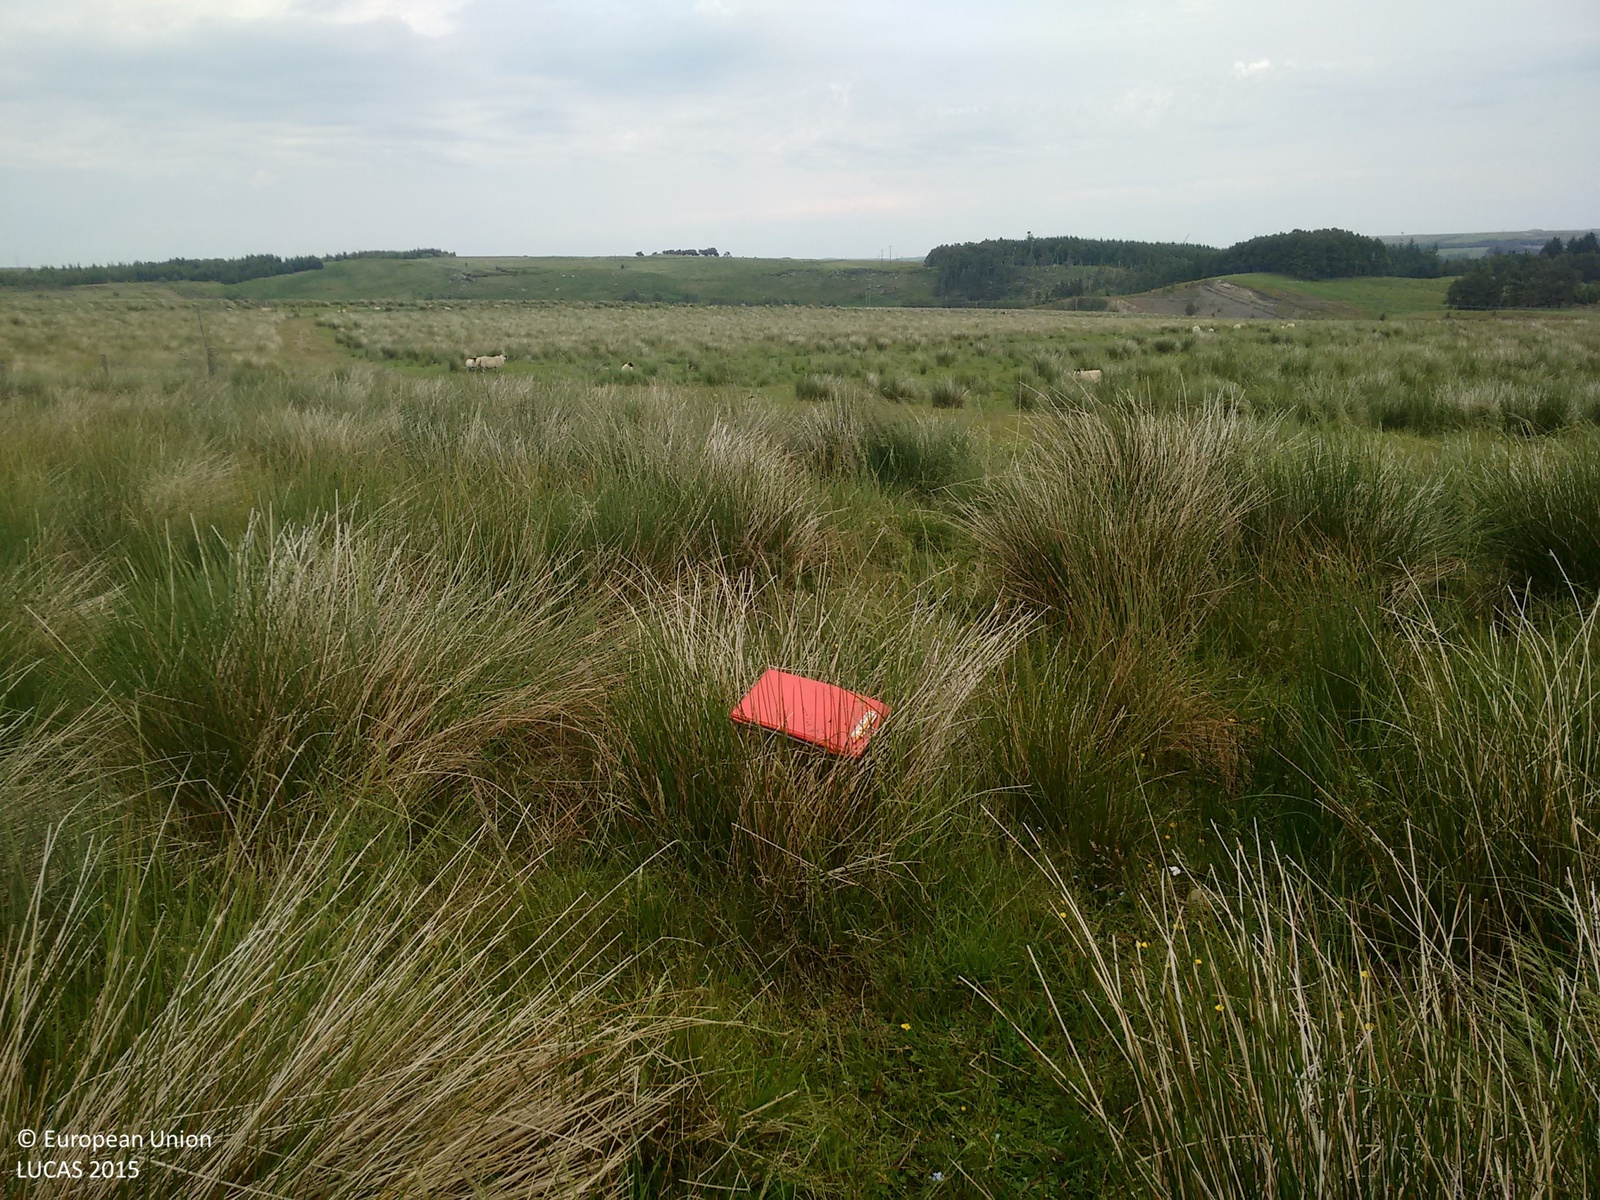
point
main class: Grassland
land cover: Grassland without tree/shrub cover
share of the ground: > 75 %
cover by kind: herbaceous plants 75 %, lichens and mosses 25 %
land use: Agriculture (excluding fallow land and kitchen gardens)
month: July
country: GB
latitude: 55.5757
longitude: -3.8695
